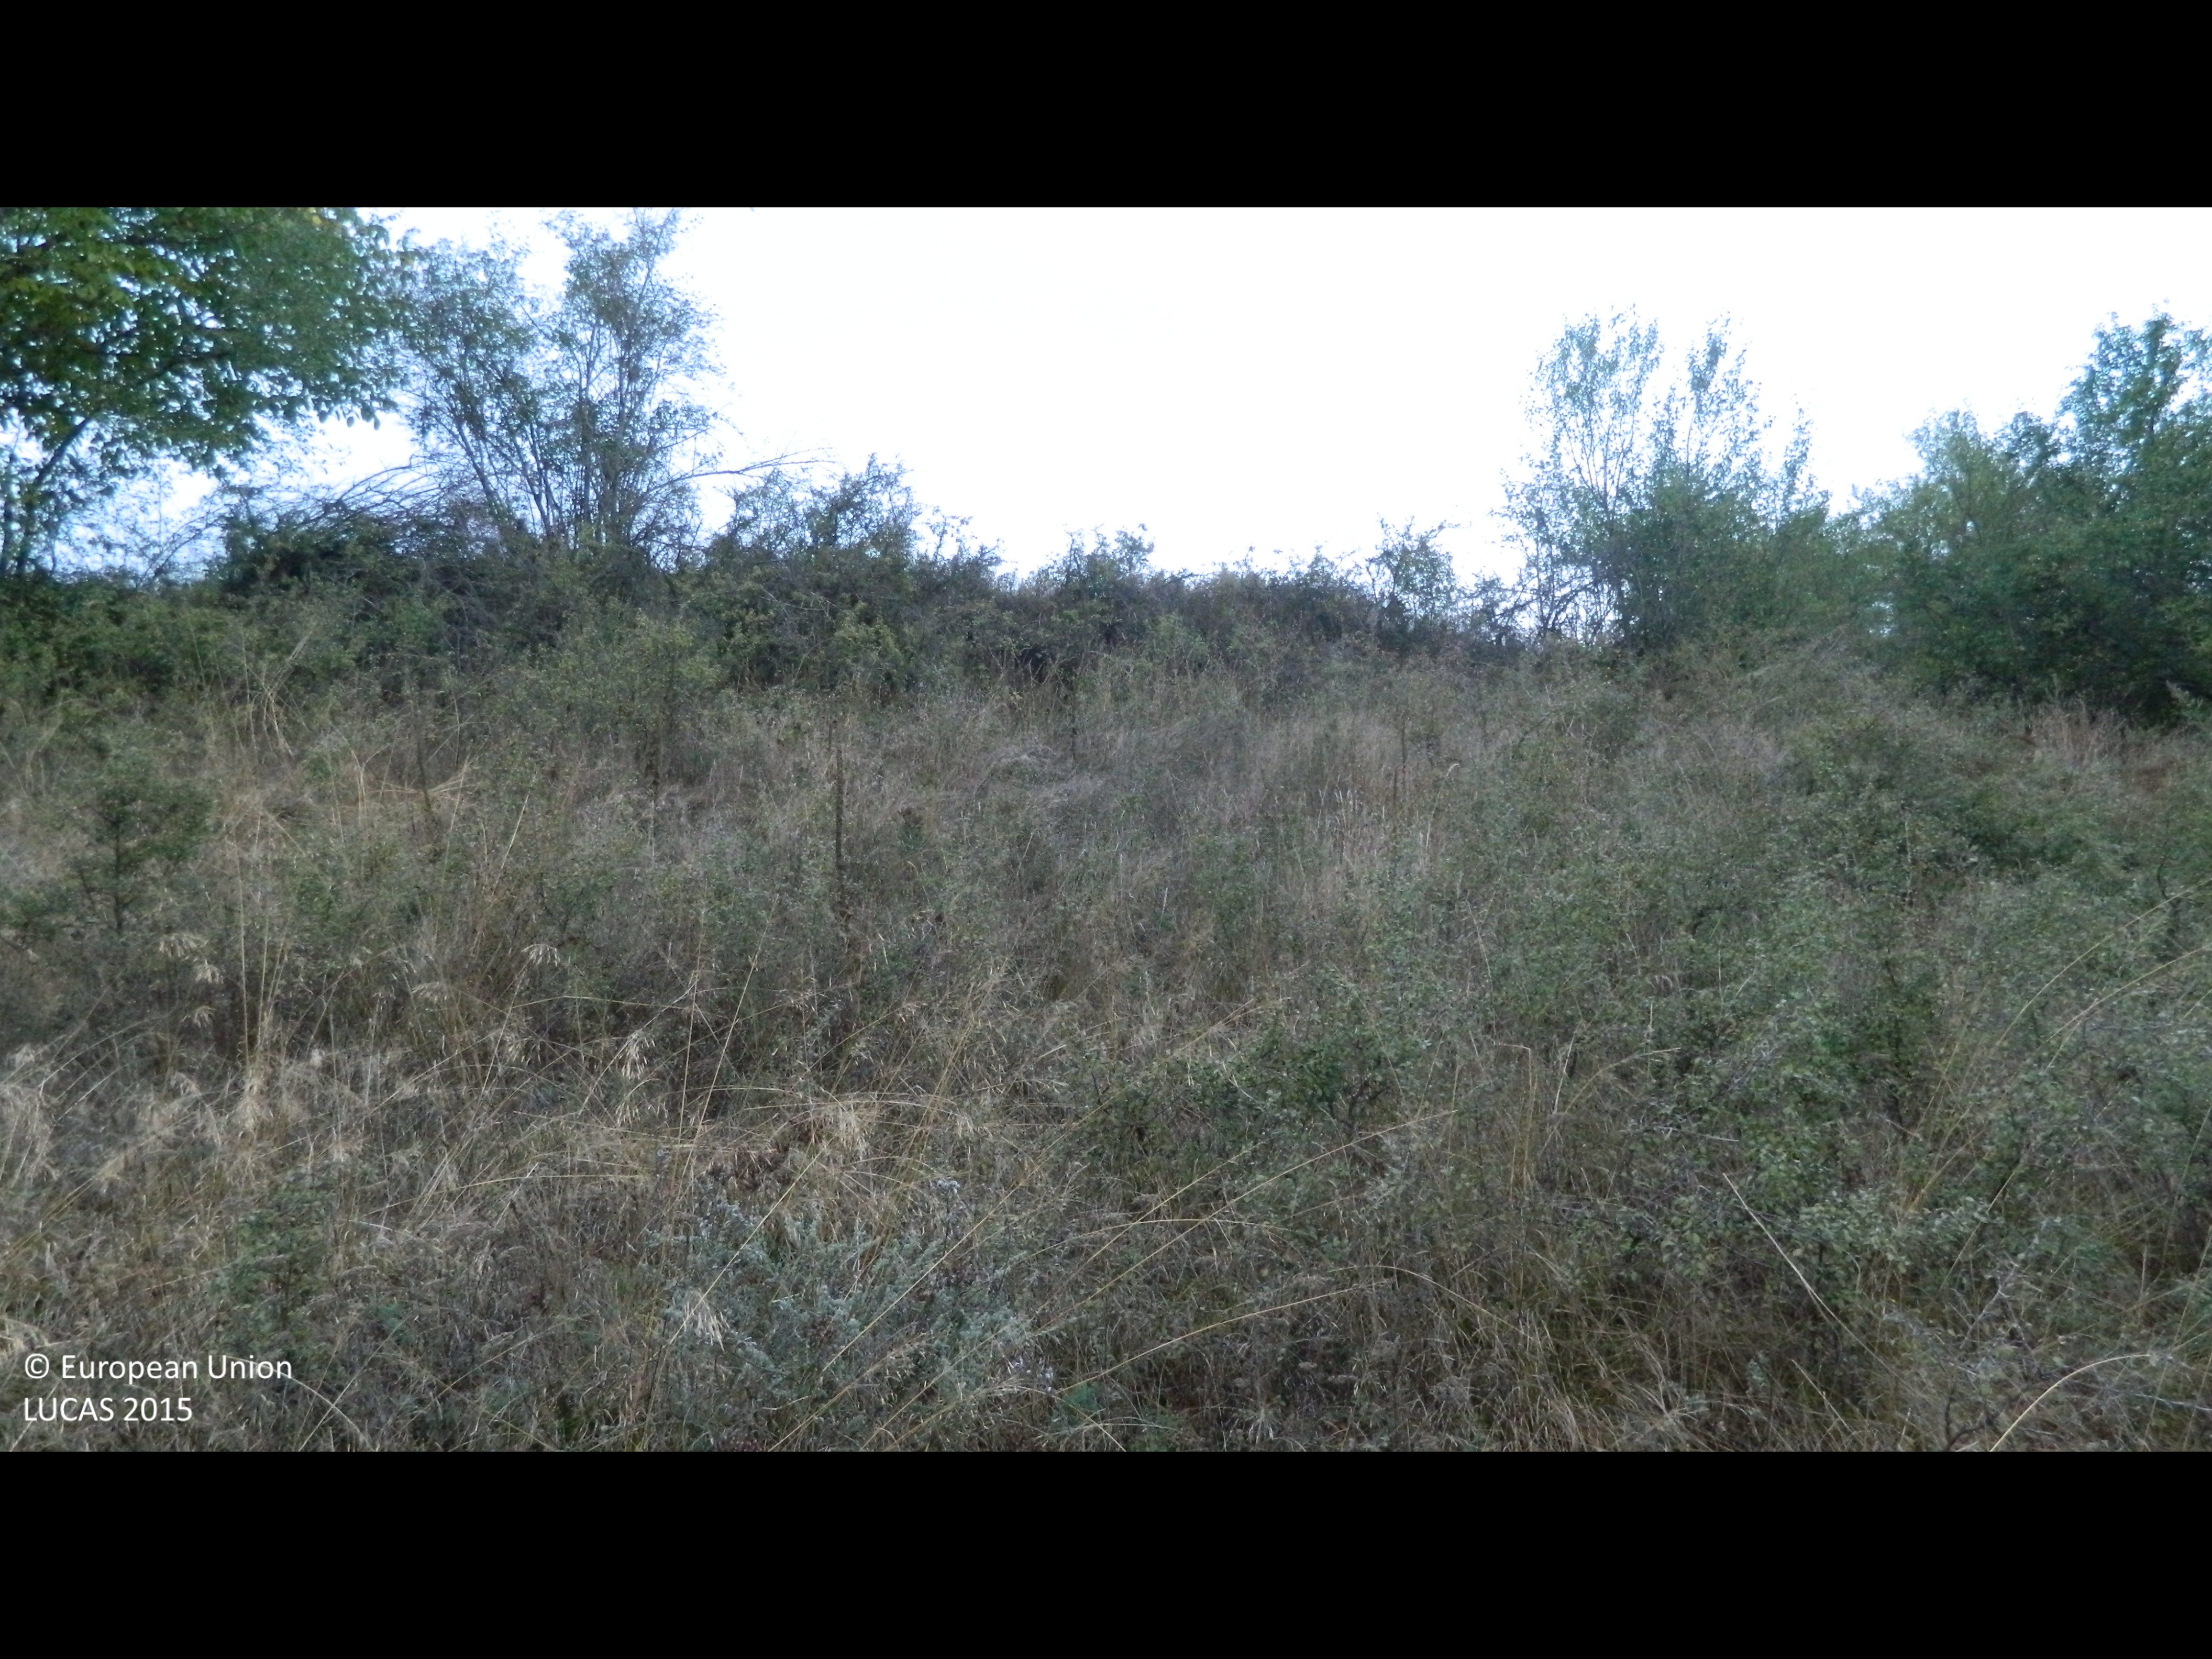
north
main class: Shrubland
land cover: Shrubland with sparse tree cover
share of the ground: > 75 %
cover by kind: shrubs 75 %, herbaceous plants 20 %, broadleaved forest trees 5 %
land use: Abandoned areas
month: September
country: BG
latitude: 41.5948
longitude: 24.0579
